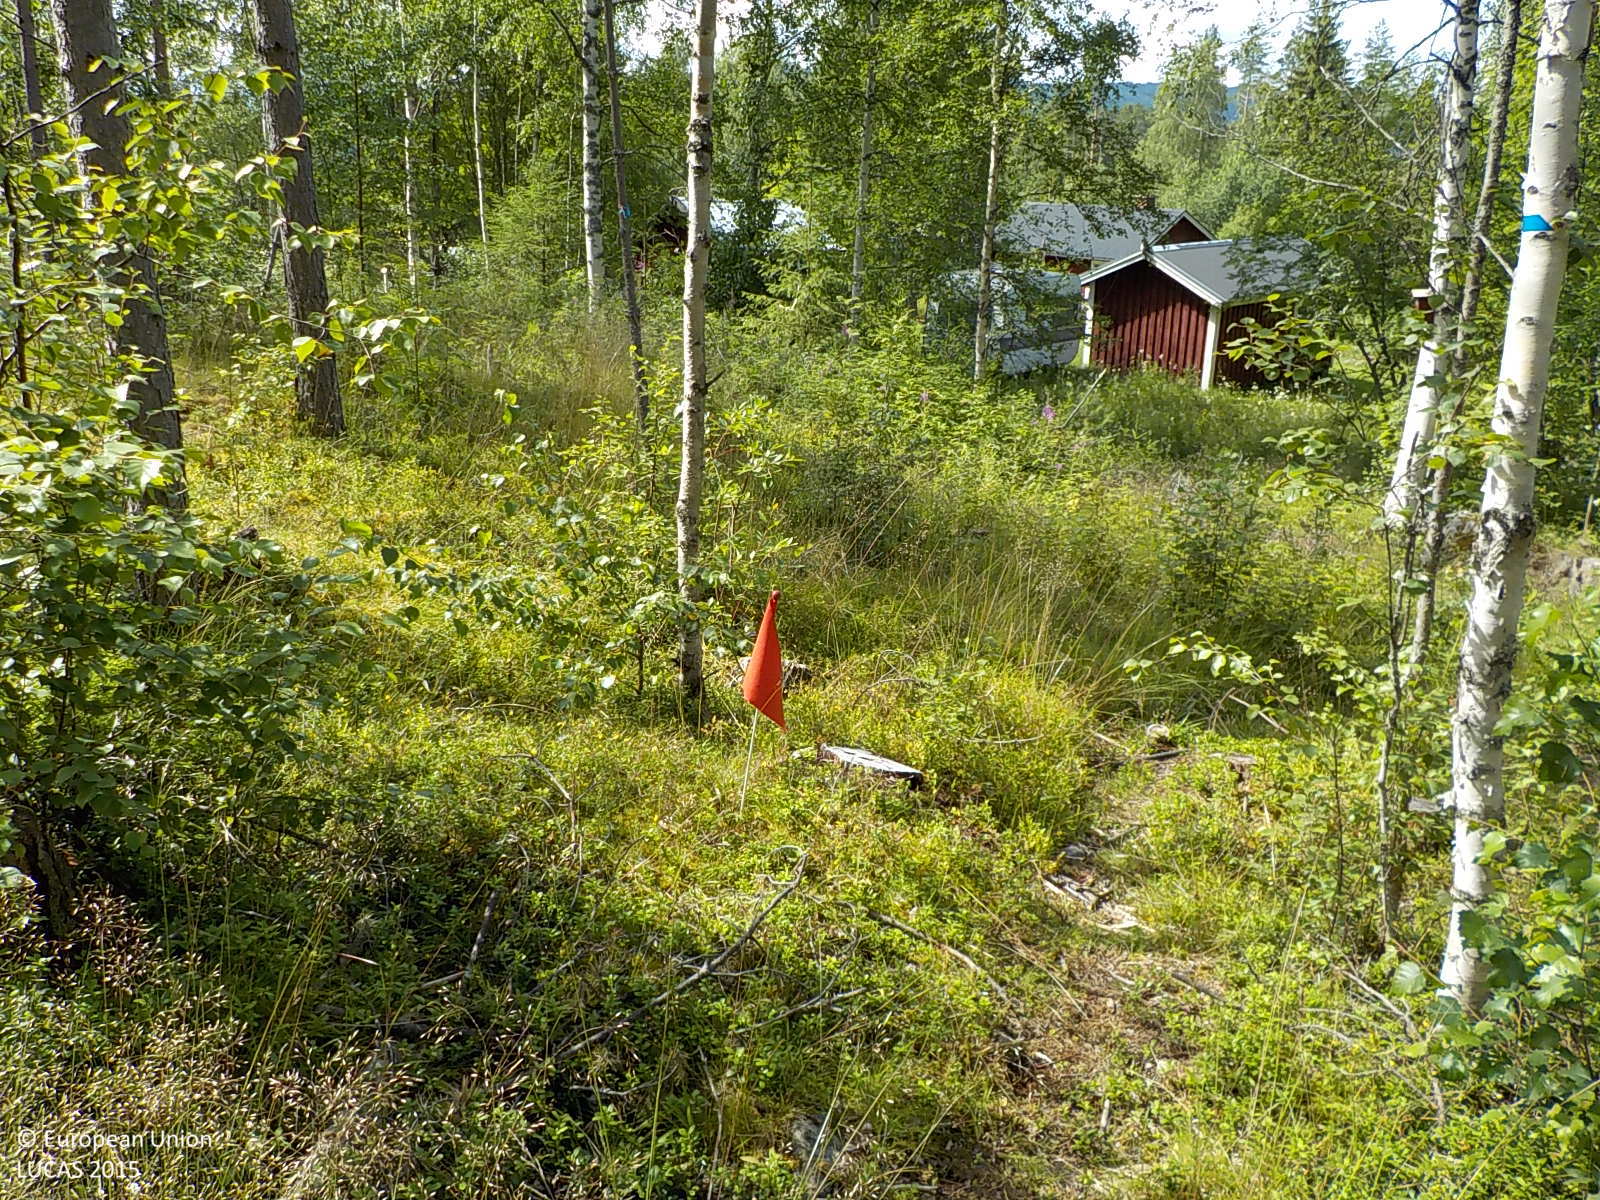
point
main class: Woodland
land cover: Pine dominated mixed woodland
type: boreal forest
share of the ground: > 75 %
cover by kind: coniferous forest trees 60 %, broadleaved forest trees 20 %, shrubs 20 %
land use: Forestry
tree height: > 5 m
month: July
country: SE
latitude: 63.2175
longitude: 17.2360
